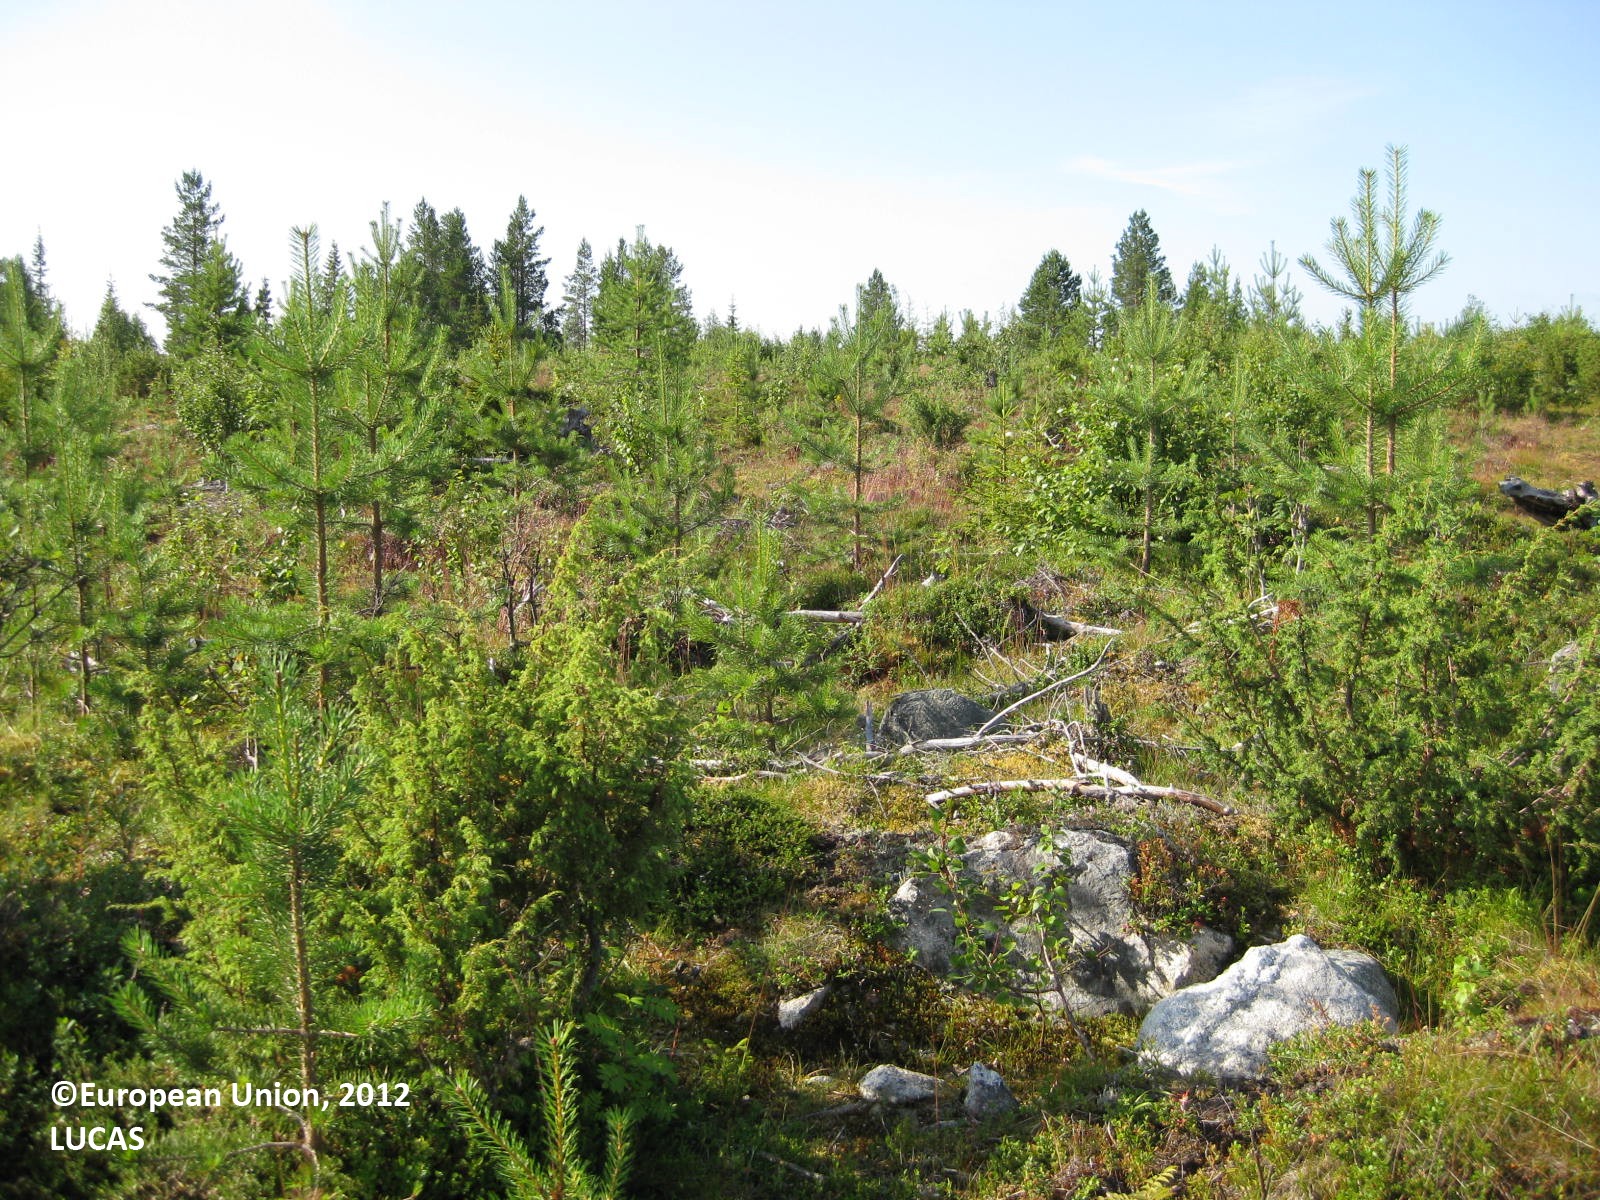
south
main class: Woodland
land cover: Pine dominated mixed woodland
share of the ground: 25 - 50 %
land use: Forestry
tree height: < 5 m
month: July
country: FI
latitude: 65.8293
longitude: 28.5659
